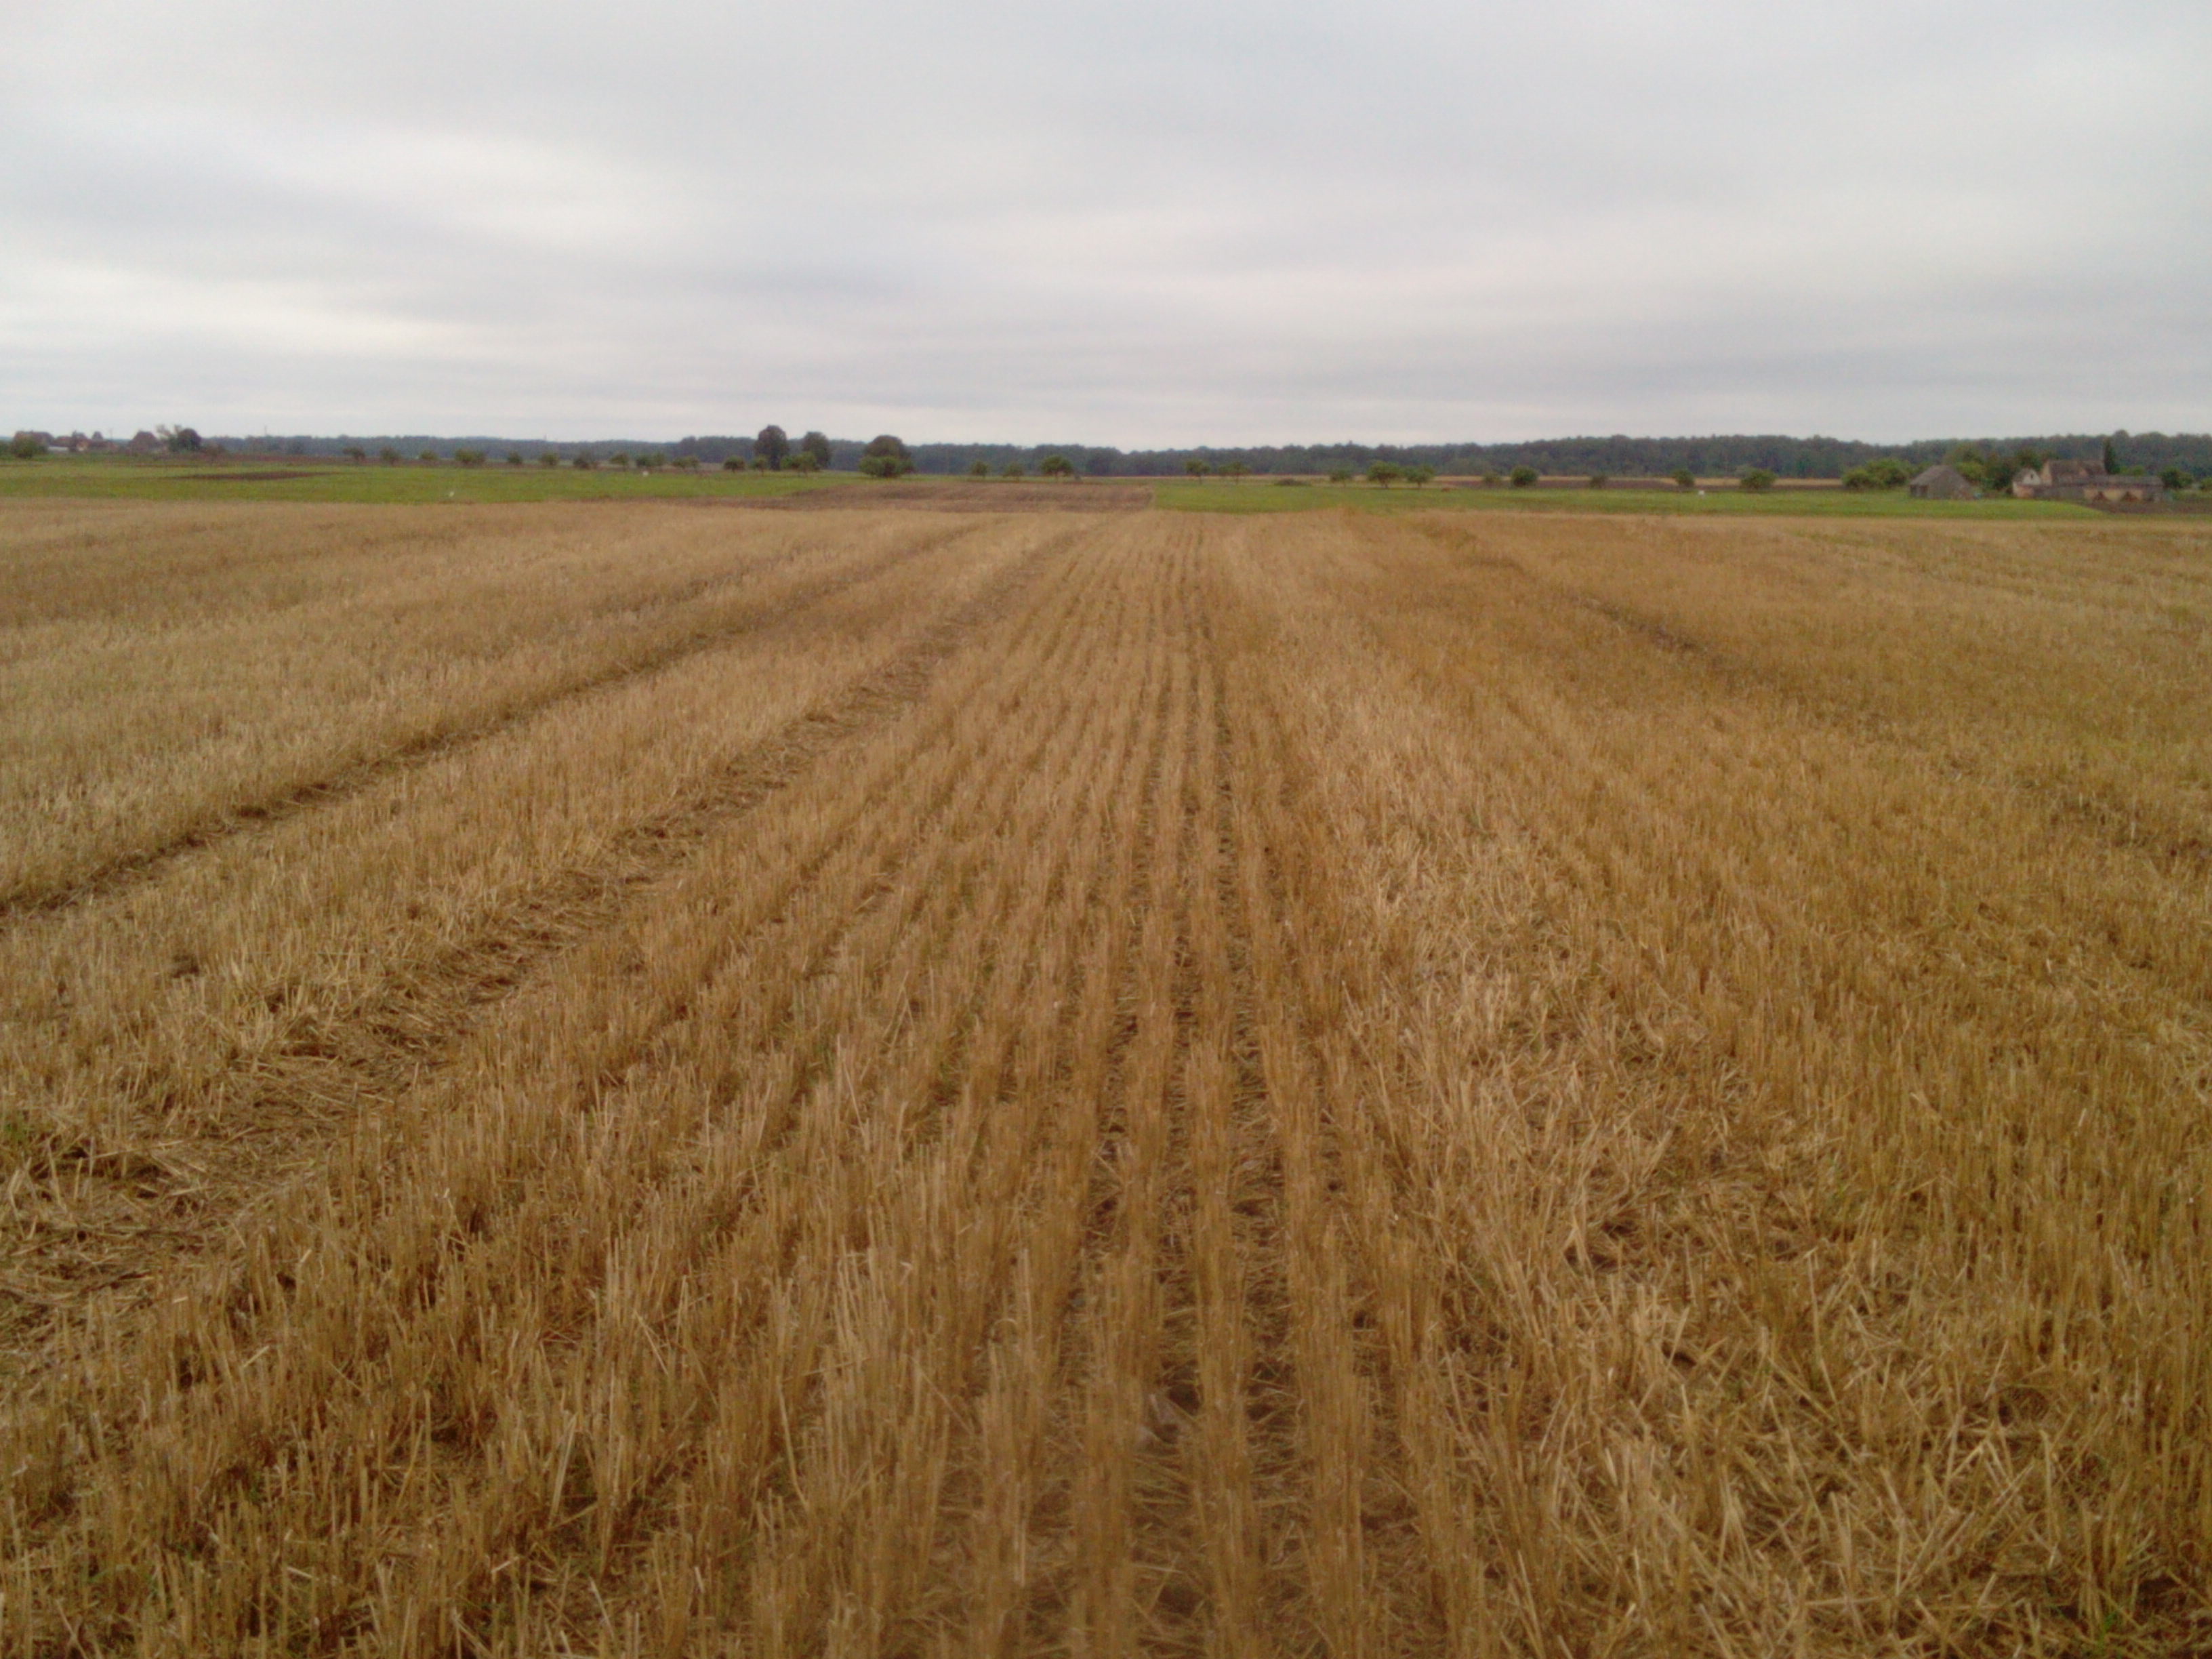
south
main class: Cropland
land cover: Barley
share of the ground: > 75 %
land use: Agriculture (excluding fallow land and kitchen gardens)
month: September
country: LT
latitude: 55.9354
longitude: 22.8885
